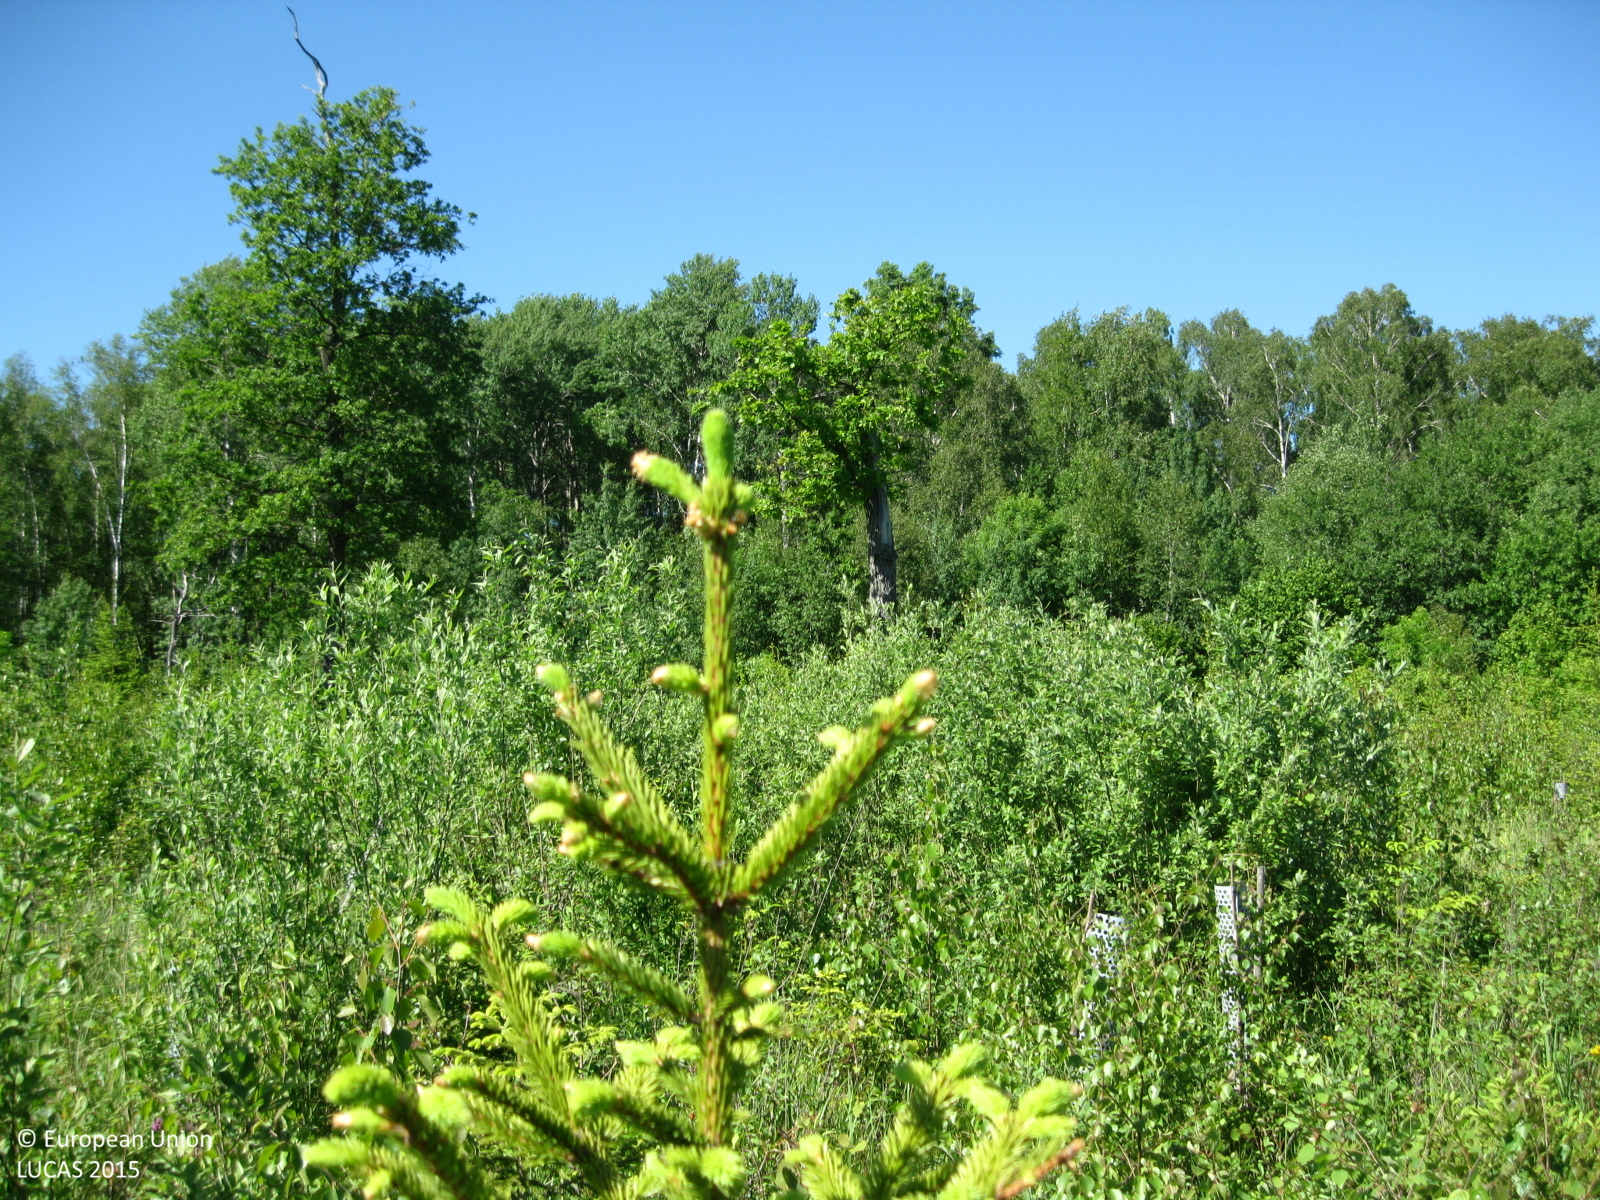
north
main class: Woodland
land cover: Spruce dominated mixed woodland
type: hemiboreal forest and nemoral coniferous forest and mixed broadleaved-coniferous forest
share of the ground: 50 - 75 %
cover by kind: coniferous forest trees 35 %, broadleaved forest trees 35 %, herbaceous plants 20 %, shrubs 10 %
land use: Forestry
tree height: < 5 m
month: June
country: LT
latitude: 55.6638
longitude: 24.0632
